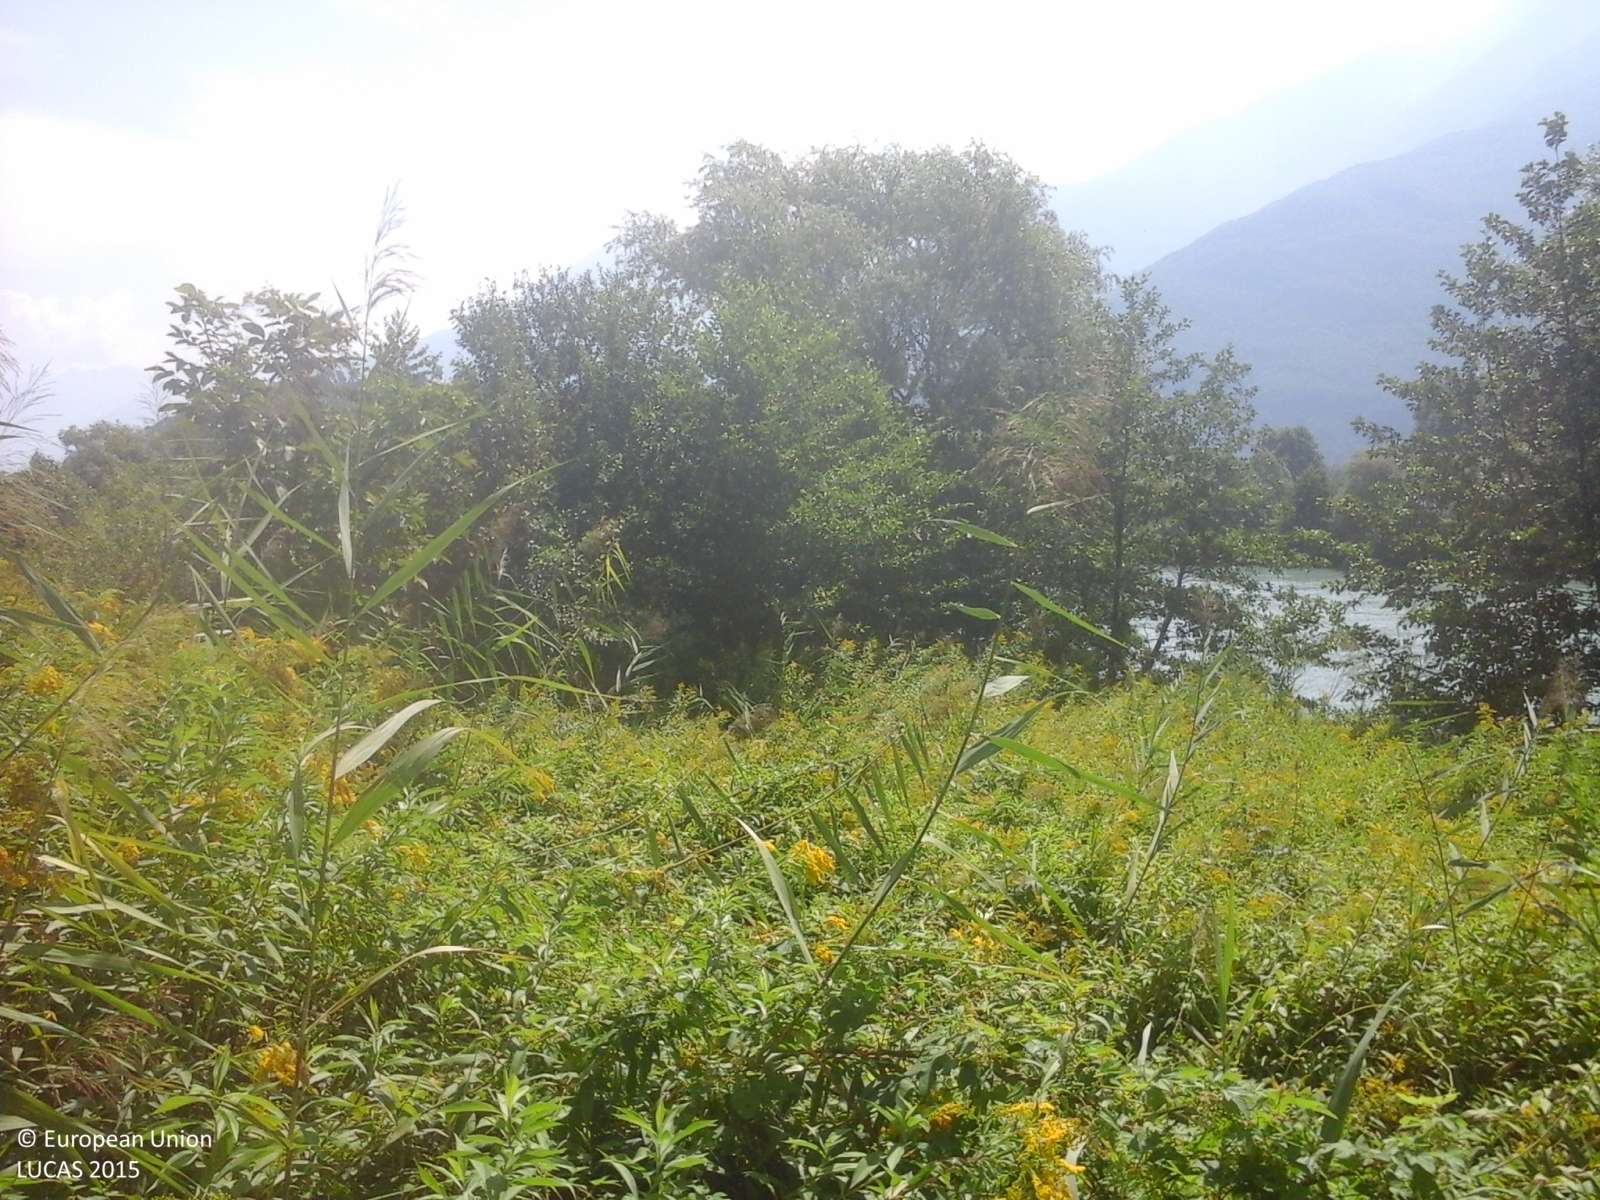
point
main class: Woodland
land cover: Broadleaved woodland
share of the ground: > 75 %
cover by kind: broadleaved forest trees 90 %, shrubs 5 %, herbaceous plants 5 %
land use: Semi-natural and natural areas not in use
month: August
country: IT
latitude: 46.1513
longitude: 9.3923
